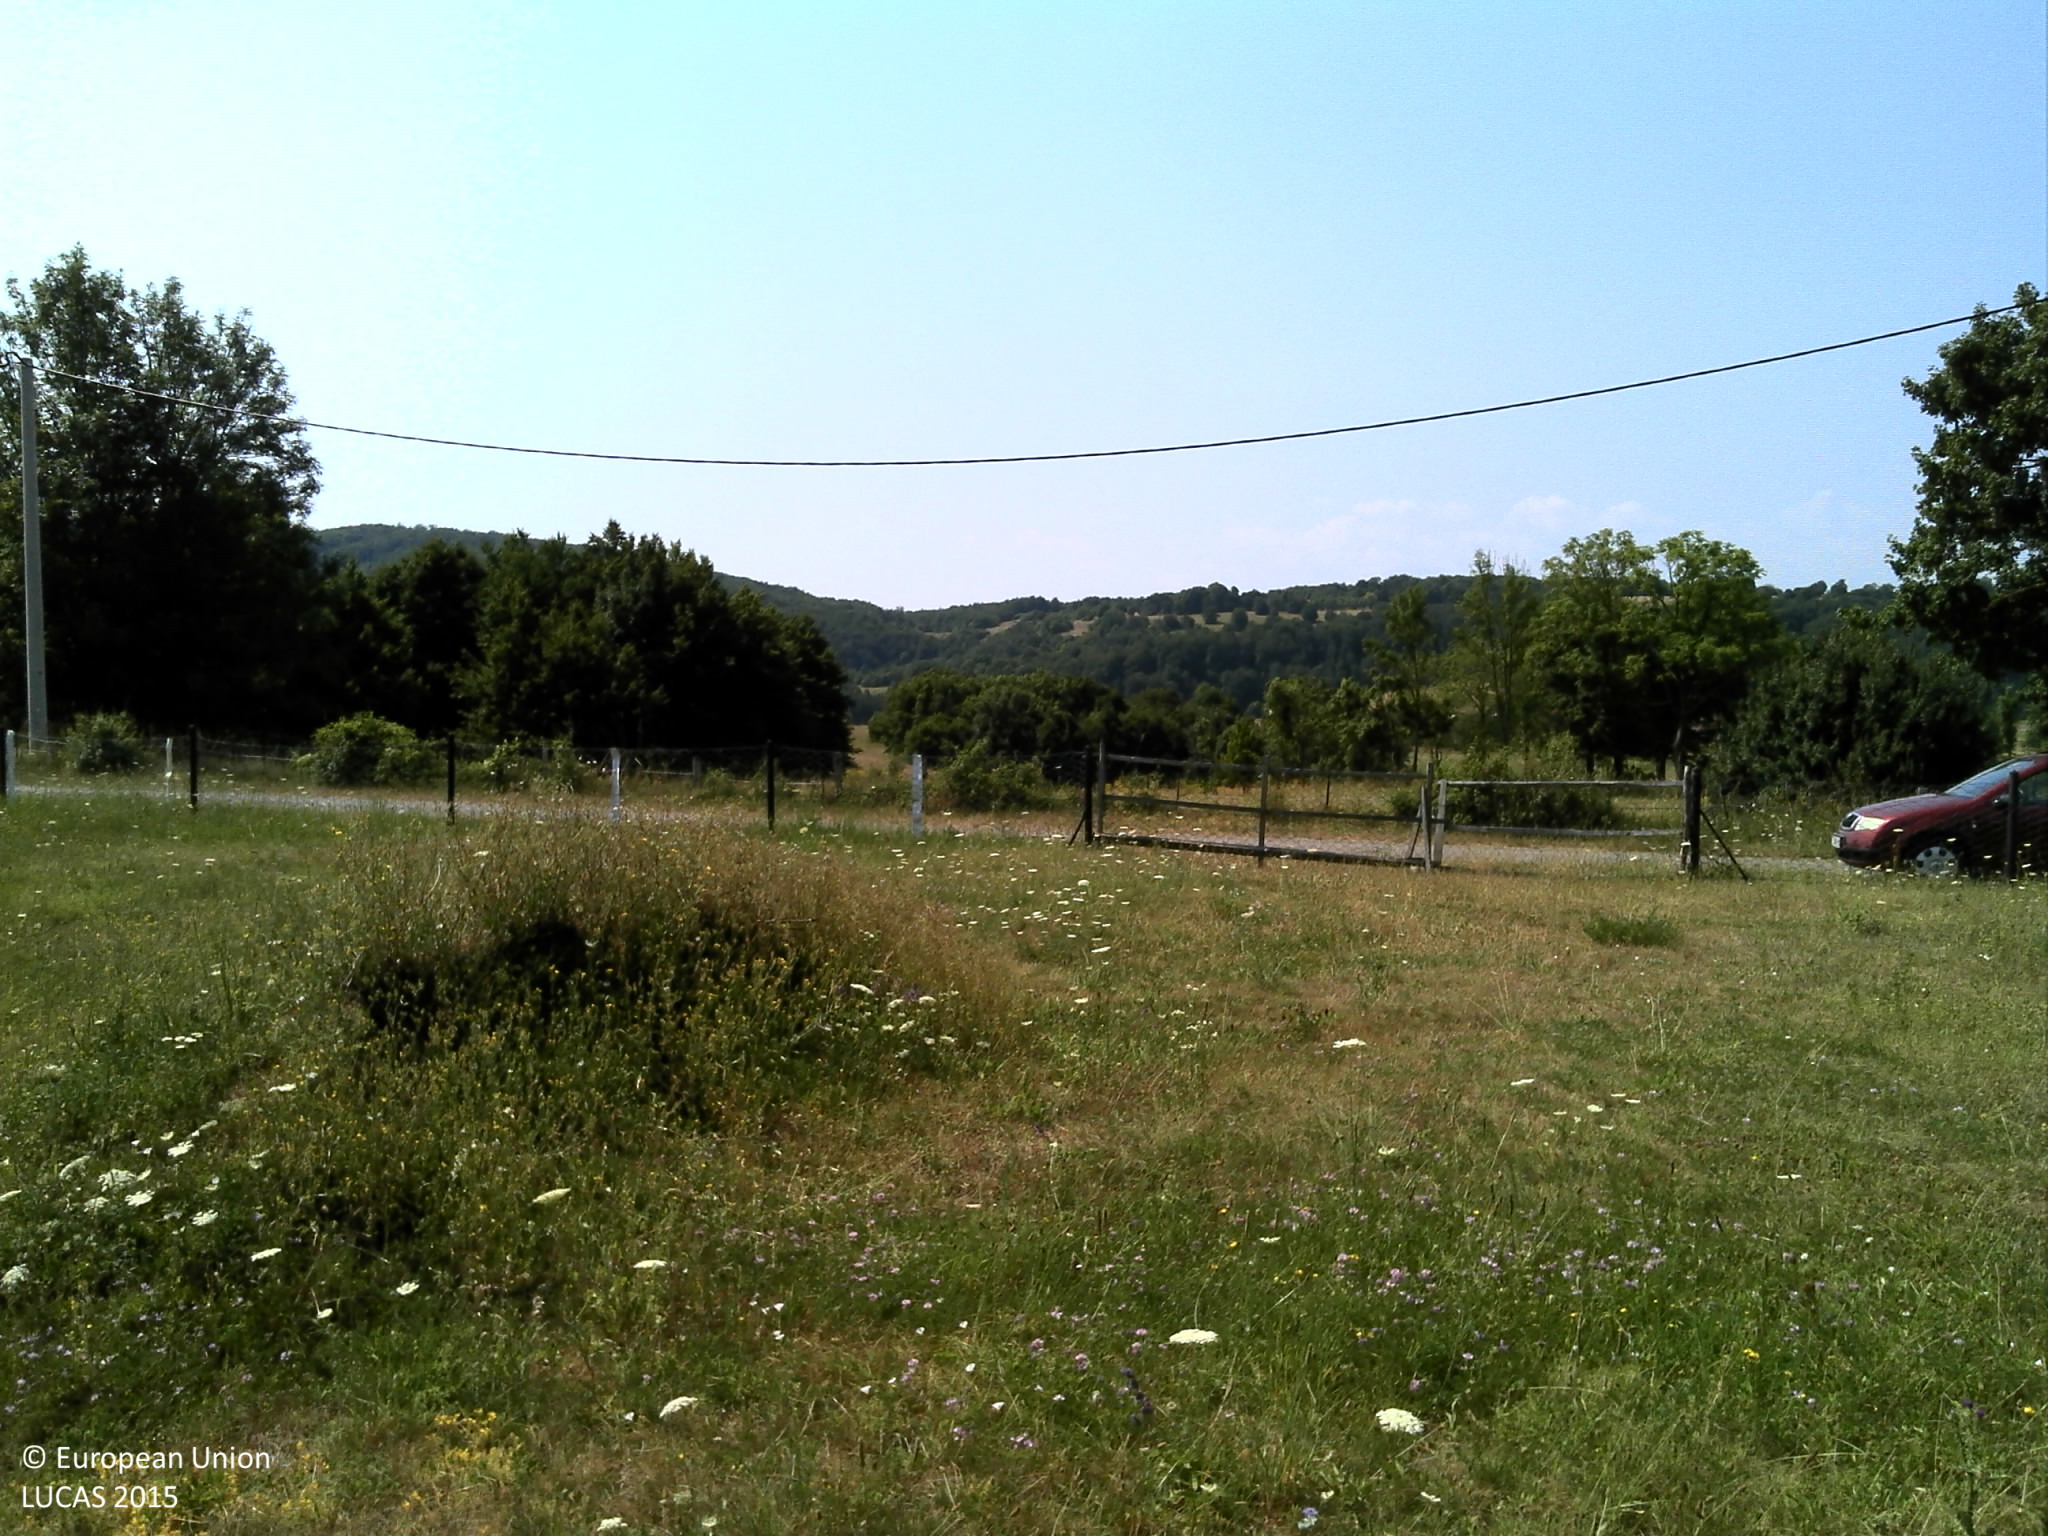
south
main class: Grassland
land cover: Grassland without tree/shrub cover
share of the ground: > 75 %
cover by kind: herbaceous plants 100 %
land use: Agriculture (excluding fallow land and kitchen gardens)
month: July
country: HR
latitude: 45.0339
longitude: 15.1862
